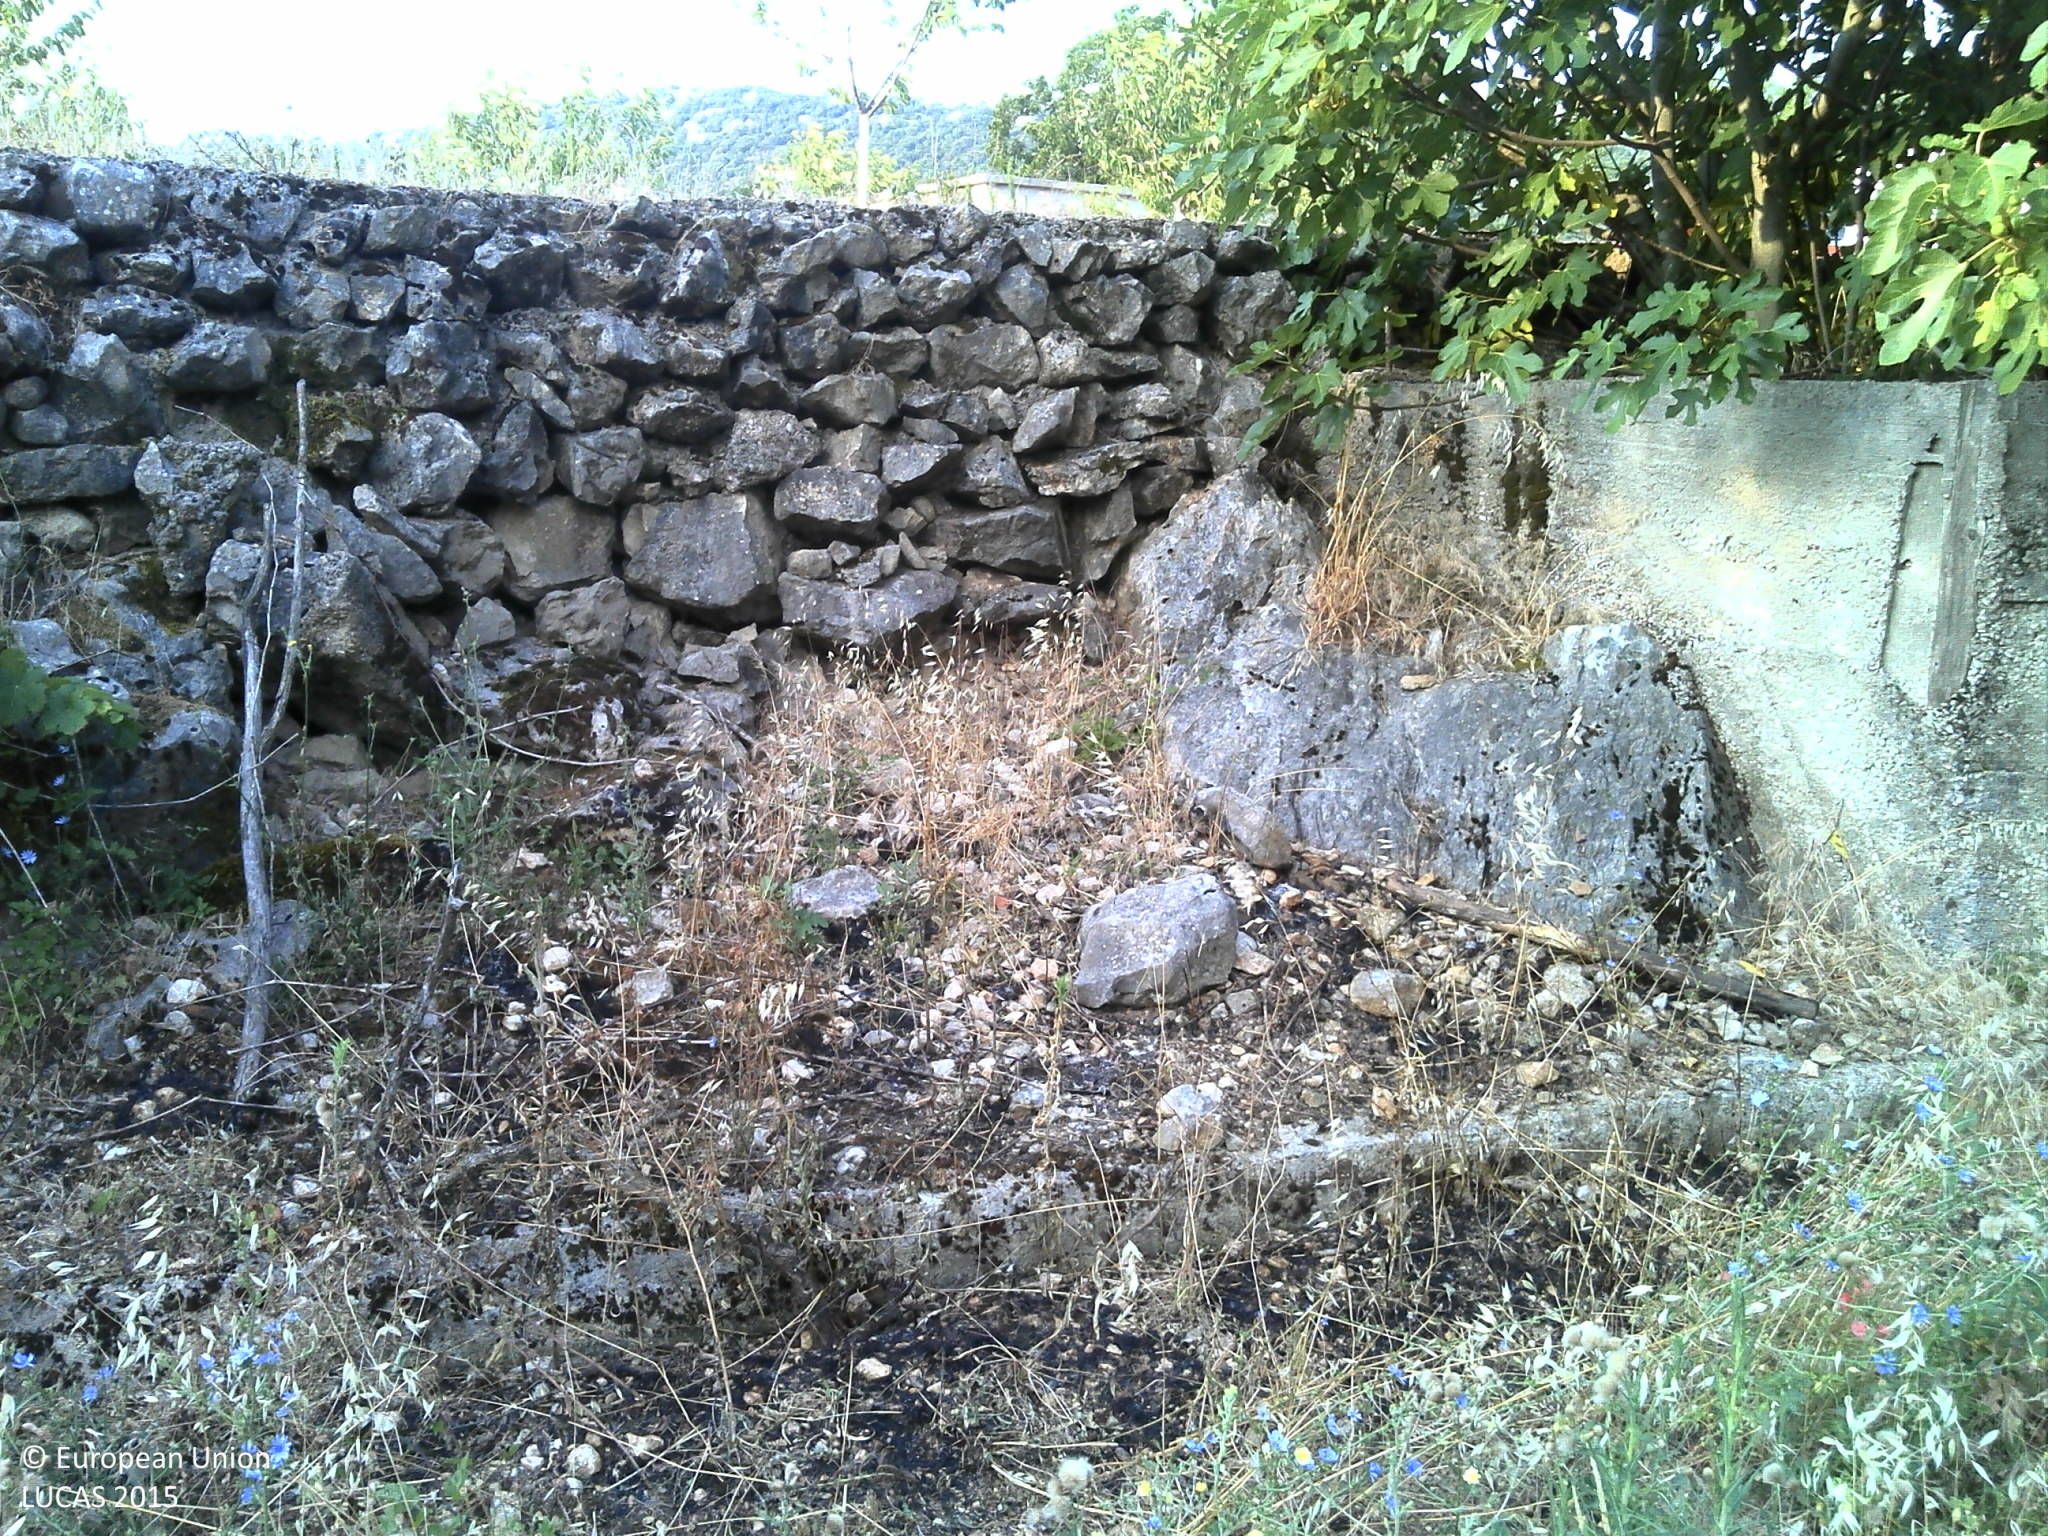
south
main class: Grassland
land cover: Grassland without tree/shrub cover
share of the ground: > 75 %
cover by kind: herbaceous plants 90 %, shrubs 5 %, consolidated bare surface 5 %
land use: Agriculture (excluding fallow land and kitchen gardens)
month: July
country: HR
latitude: 43.4331
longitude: 16.8970
